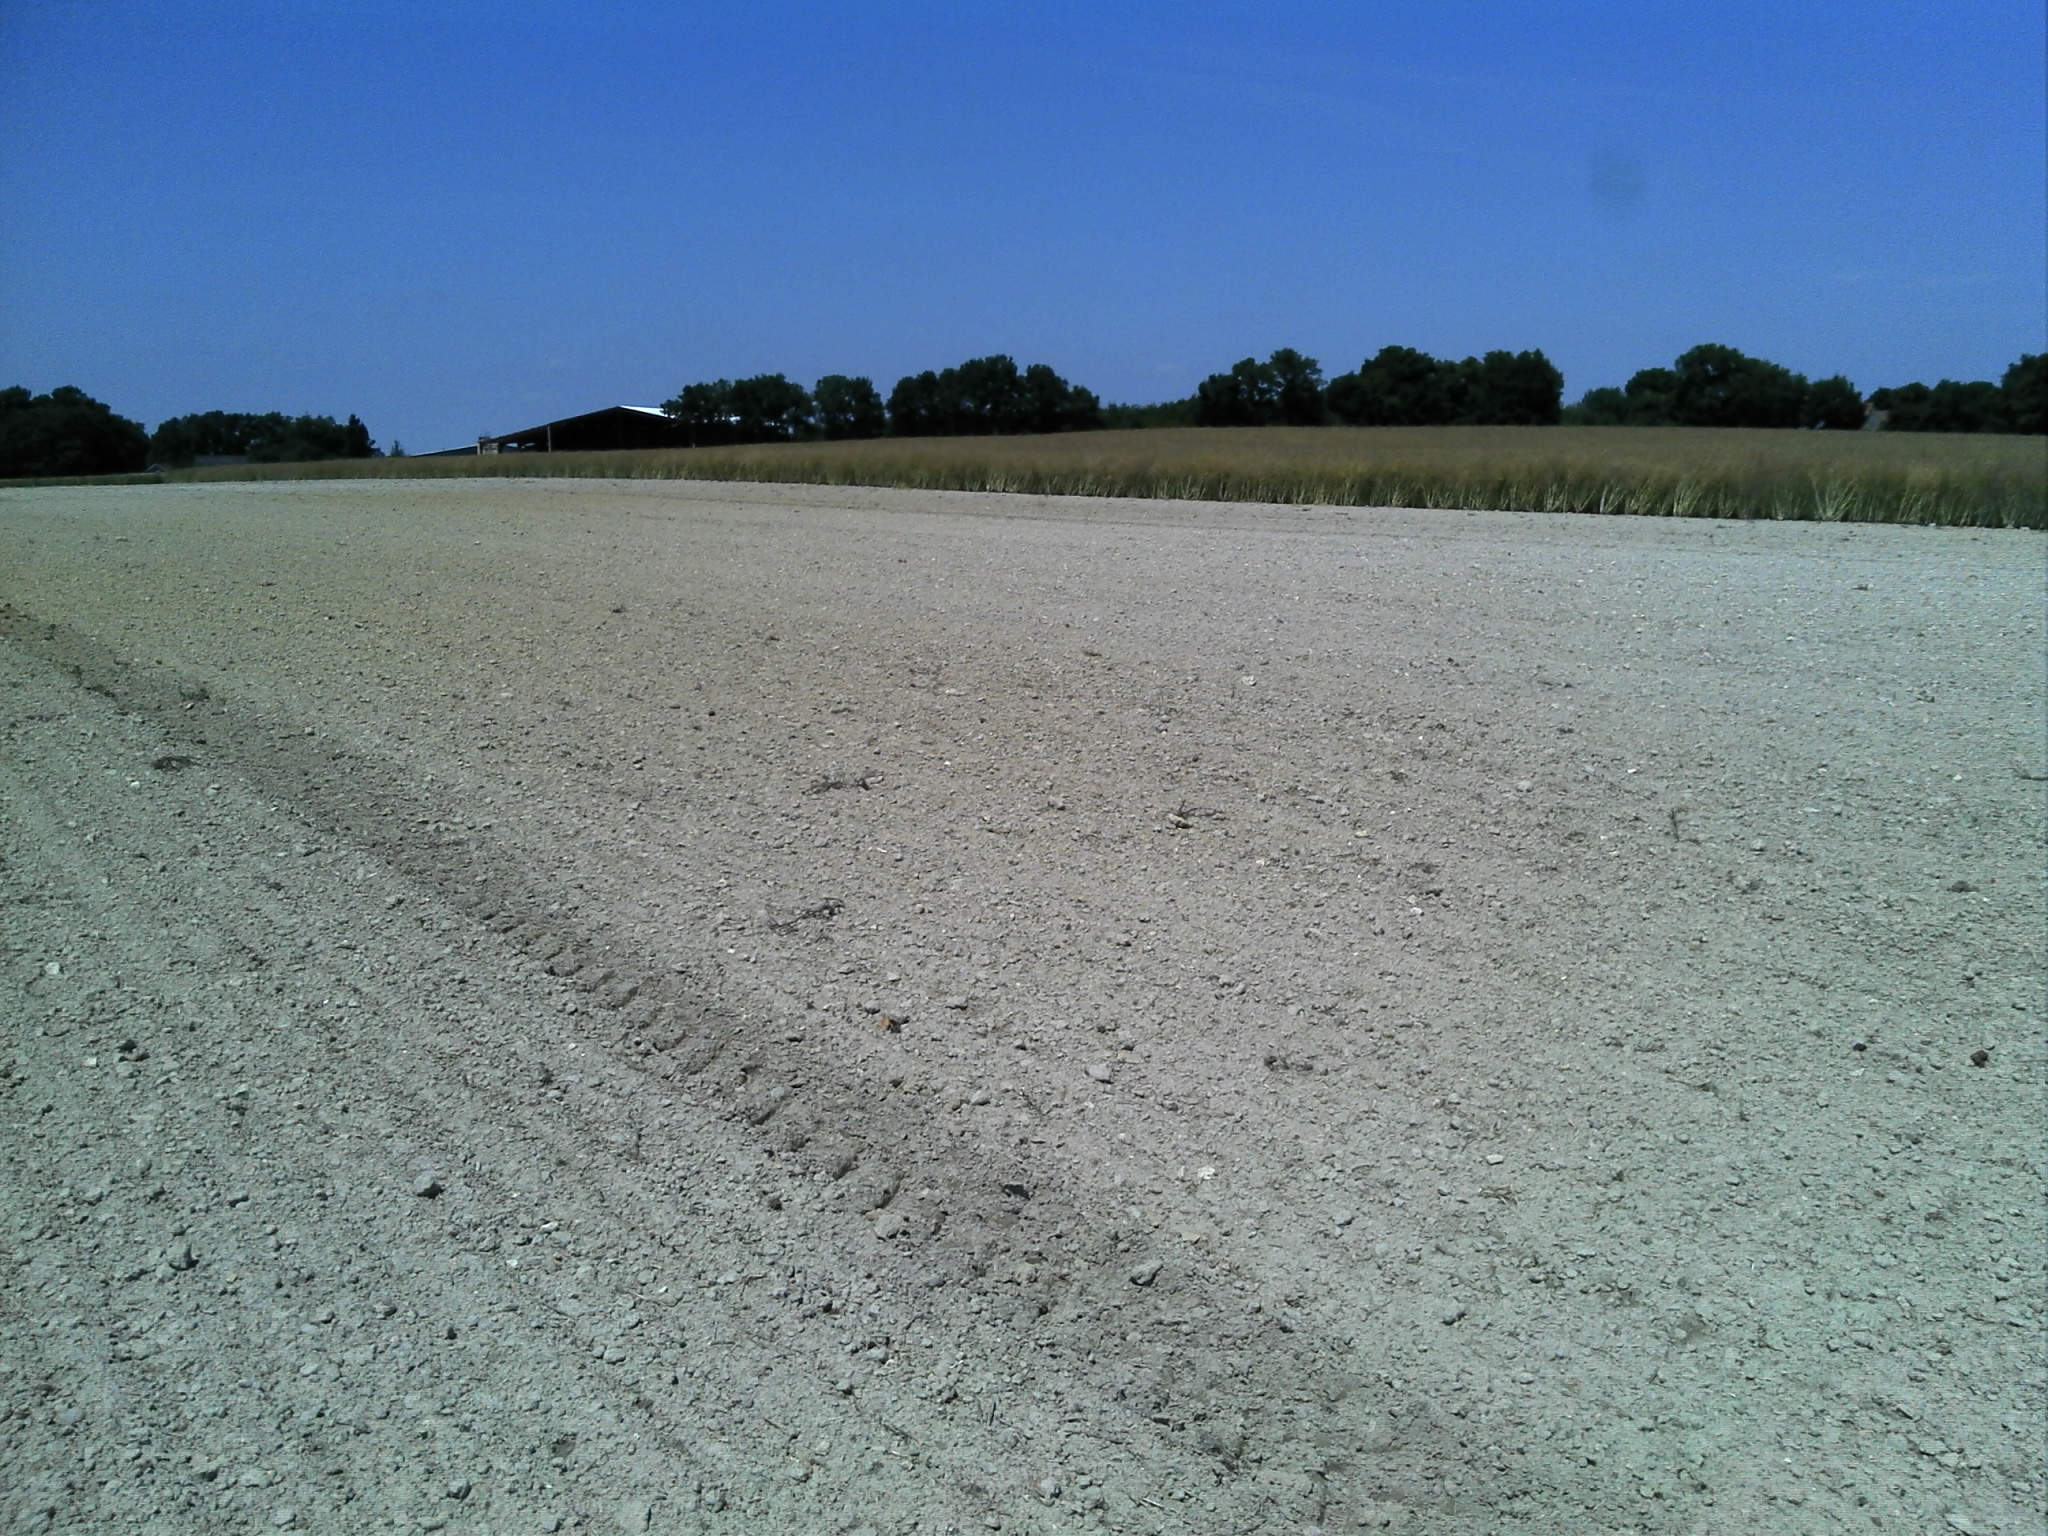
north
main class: Cropland
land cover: Maize
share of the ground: < 10 %
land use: Agriculture (excluding fallow land and kitchen gardens)
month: June
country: FR
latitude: 47.1451
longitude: 1.4021
